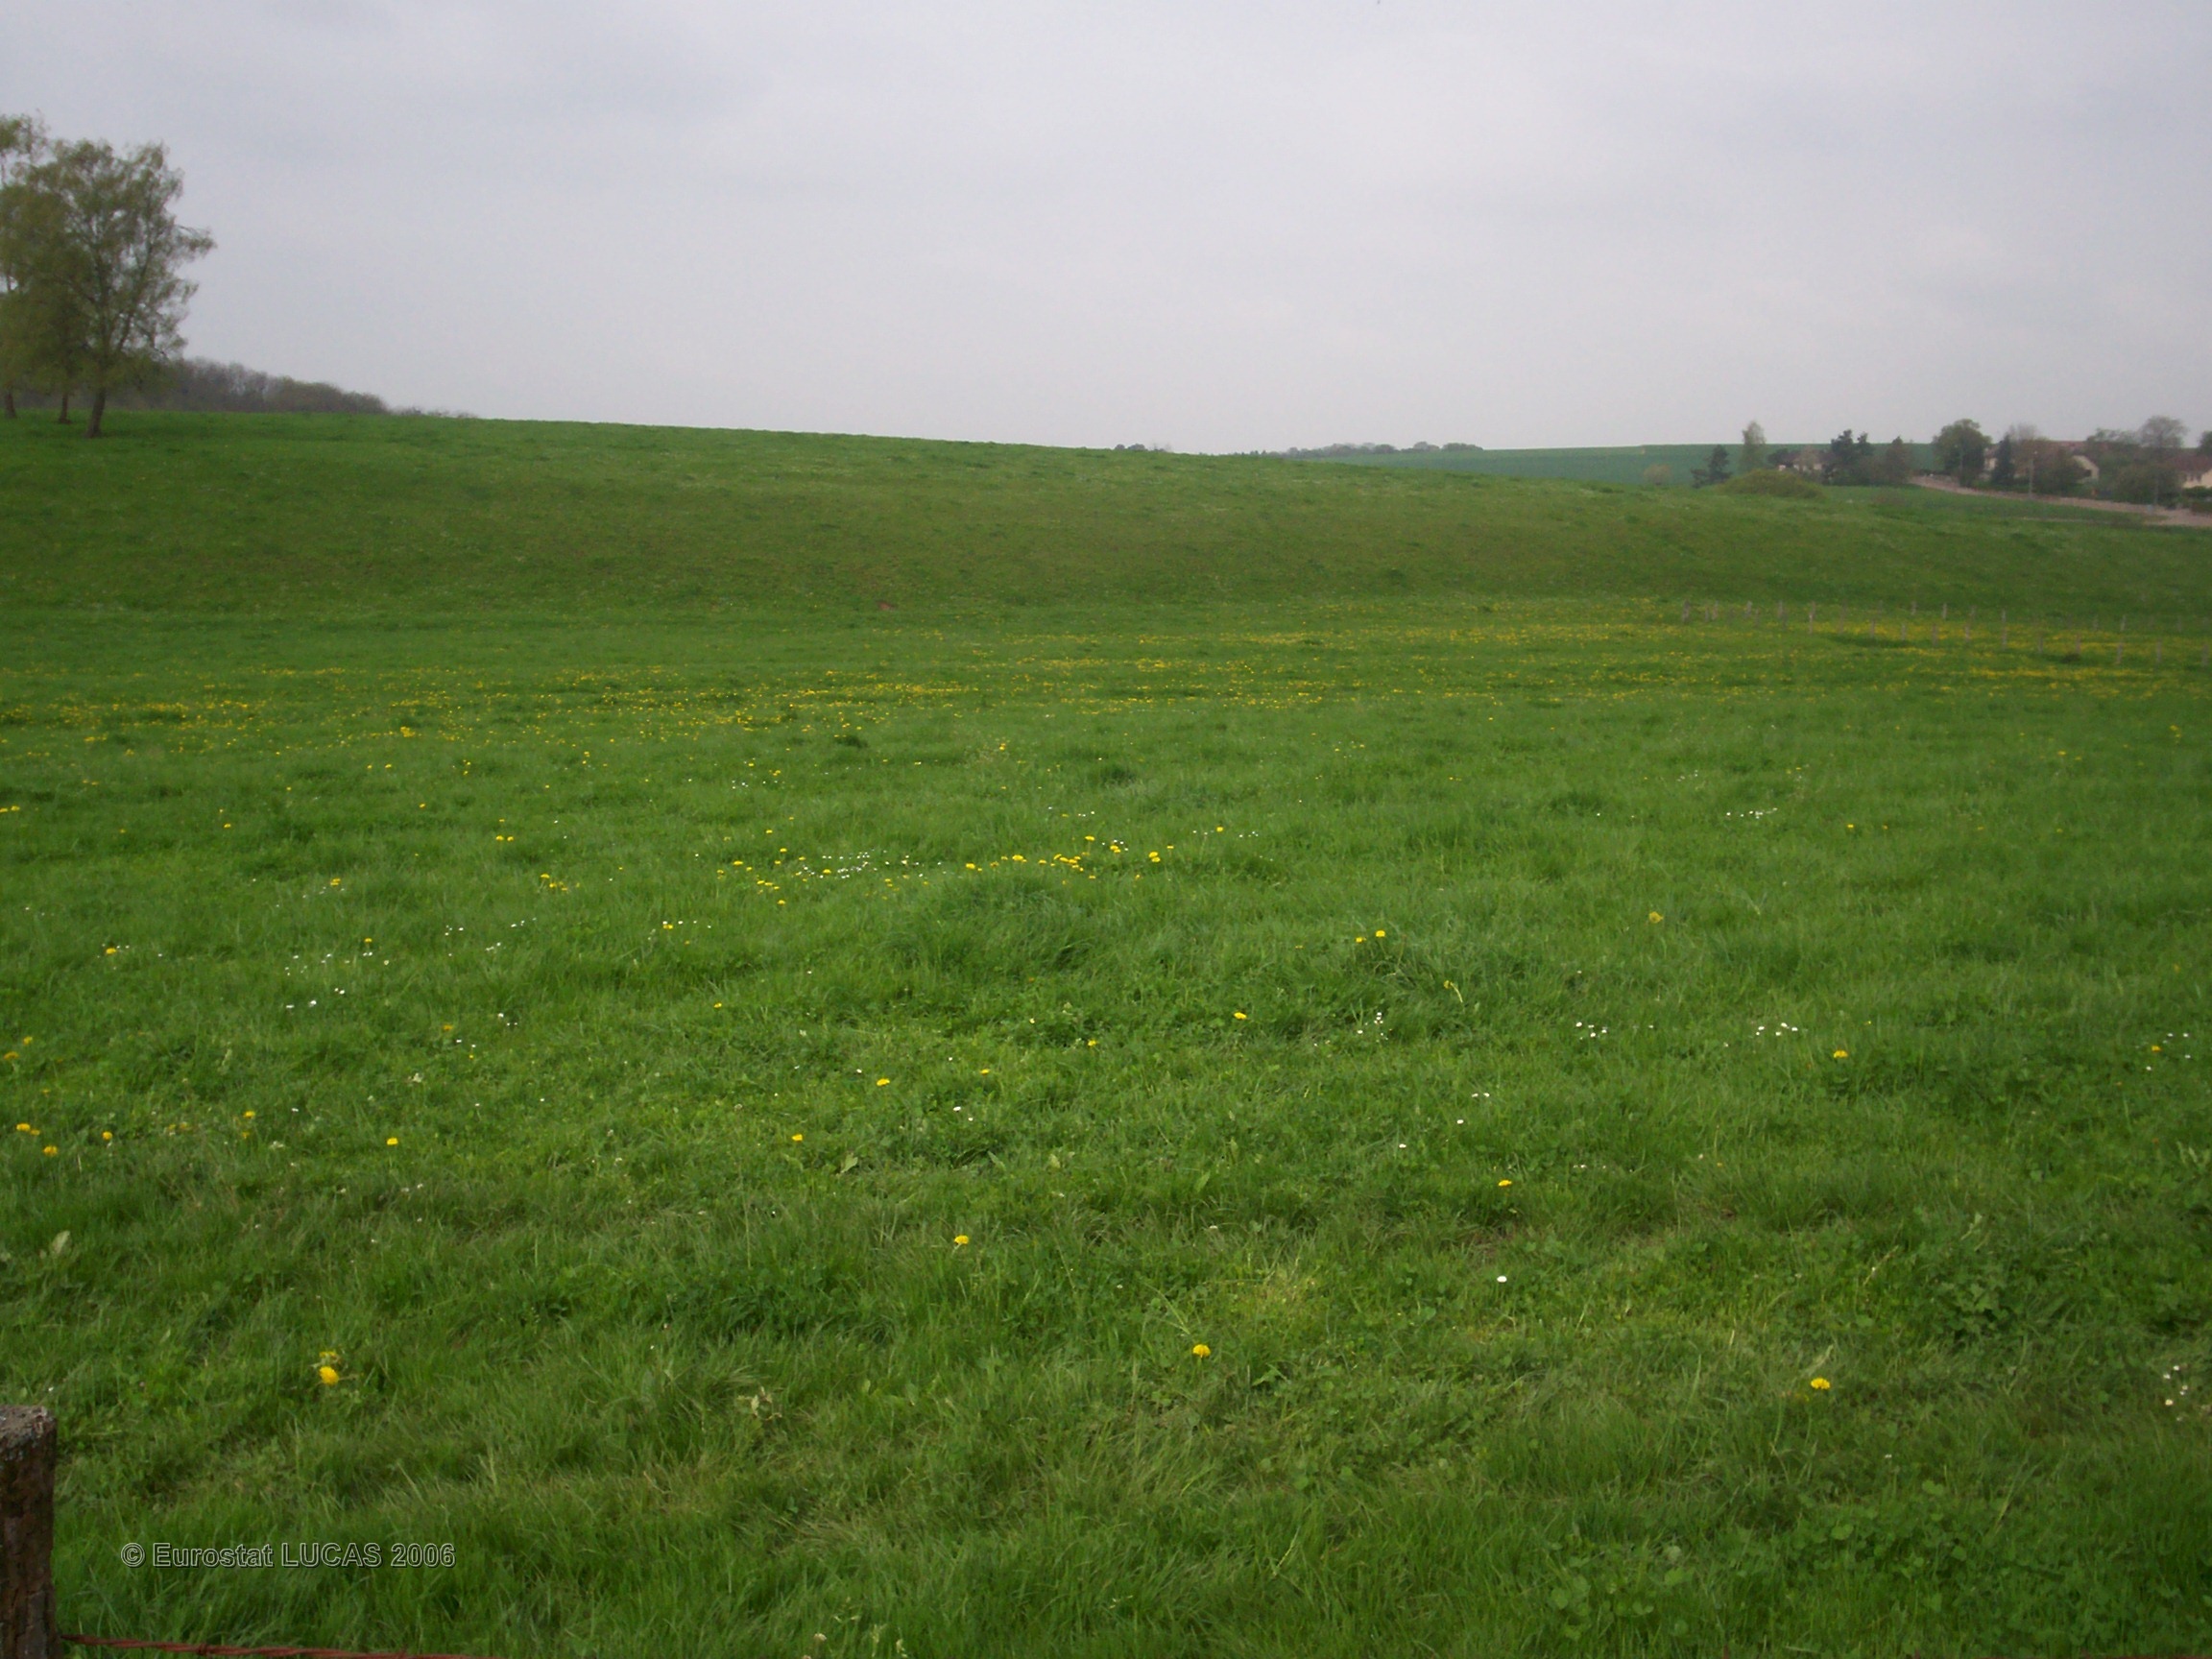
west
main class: Grassland
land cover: Grassland without tree/shrub cover
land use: Agriculture (excluding fallow land and kitchen gardens)
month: April
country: FR
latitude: 47.6103
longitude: 5.9969
